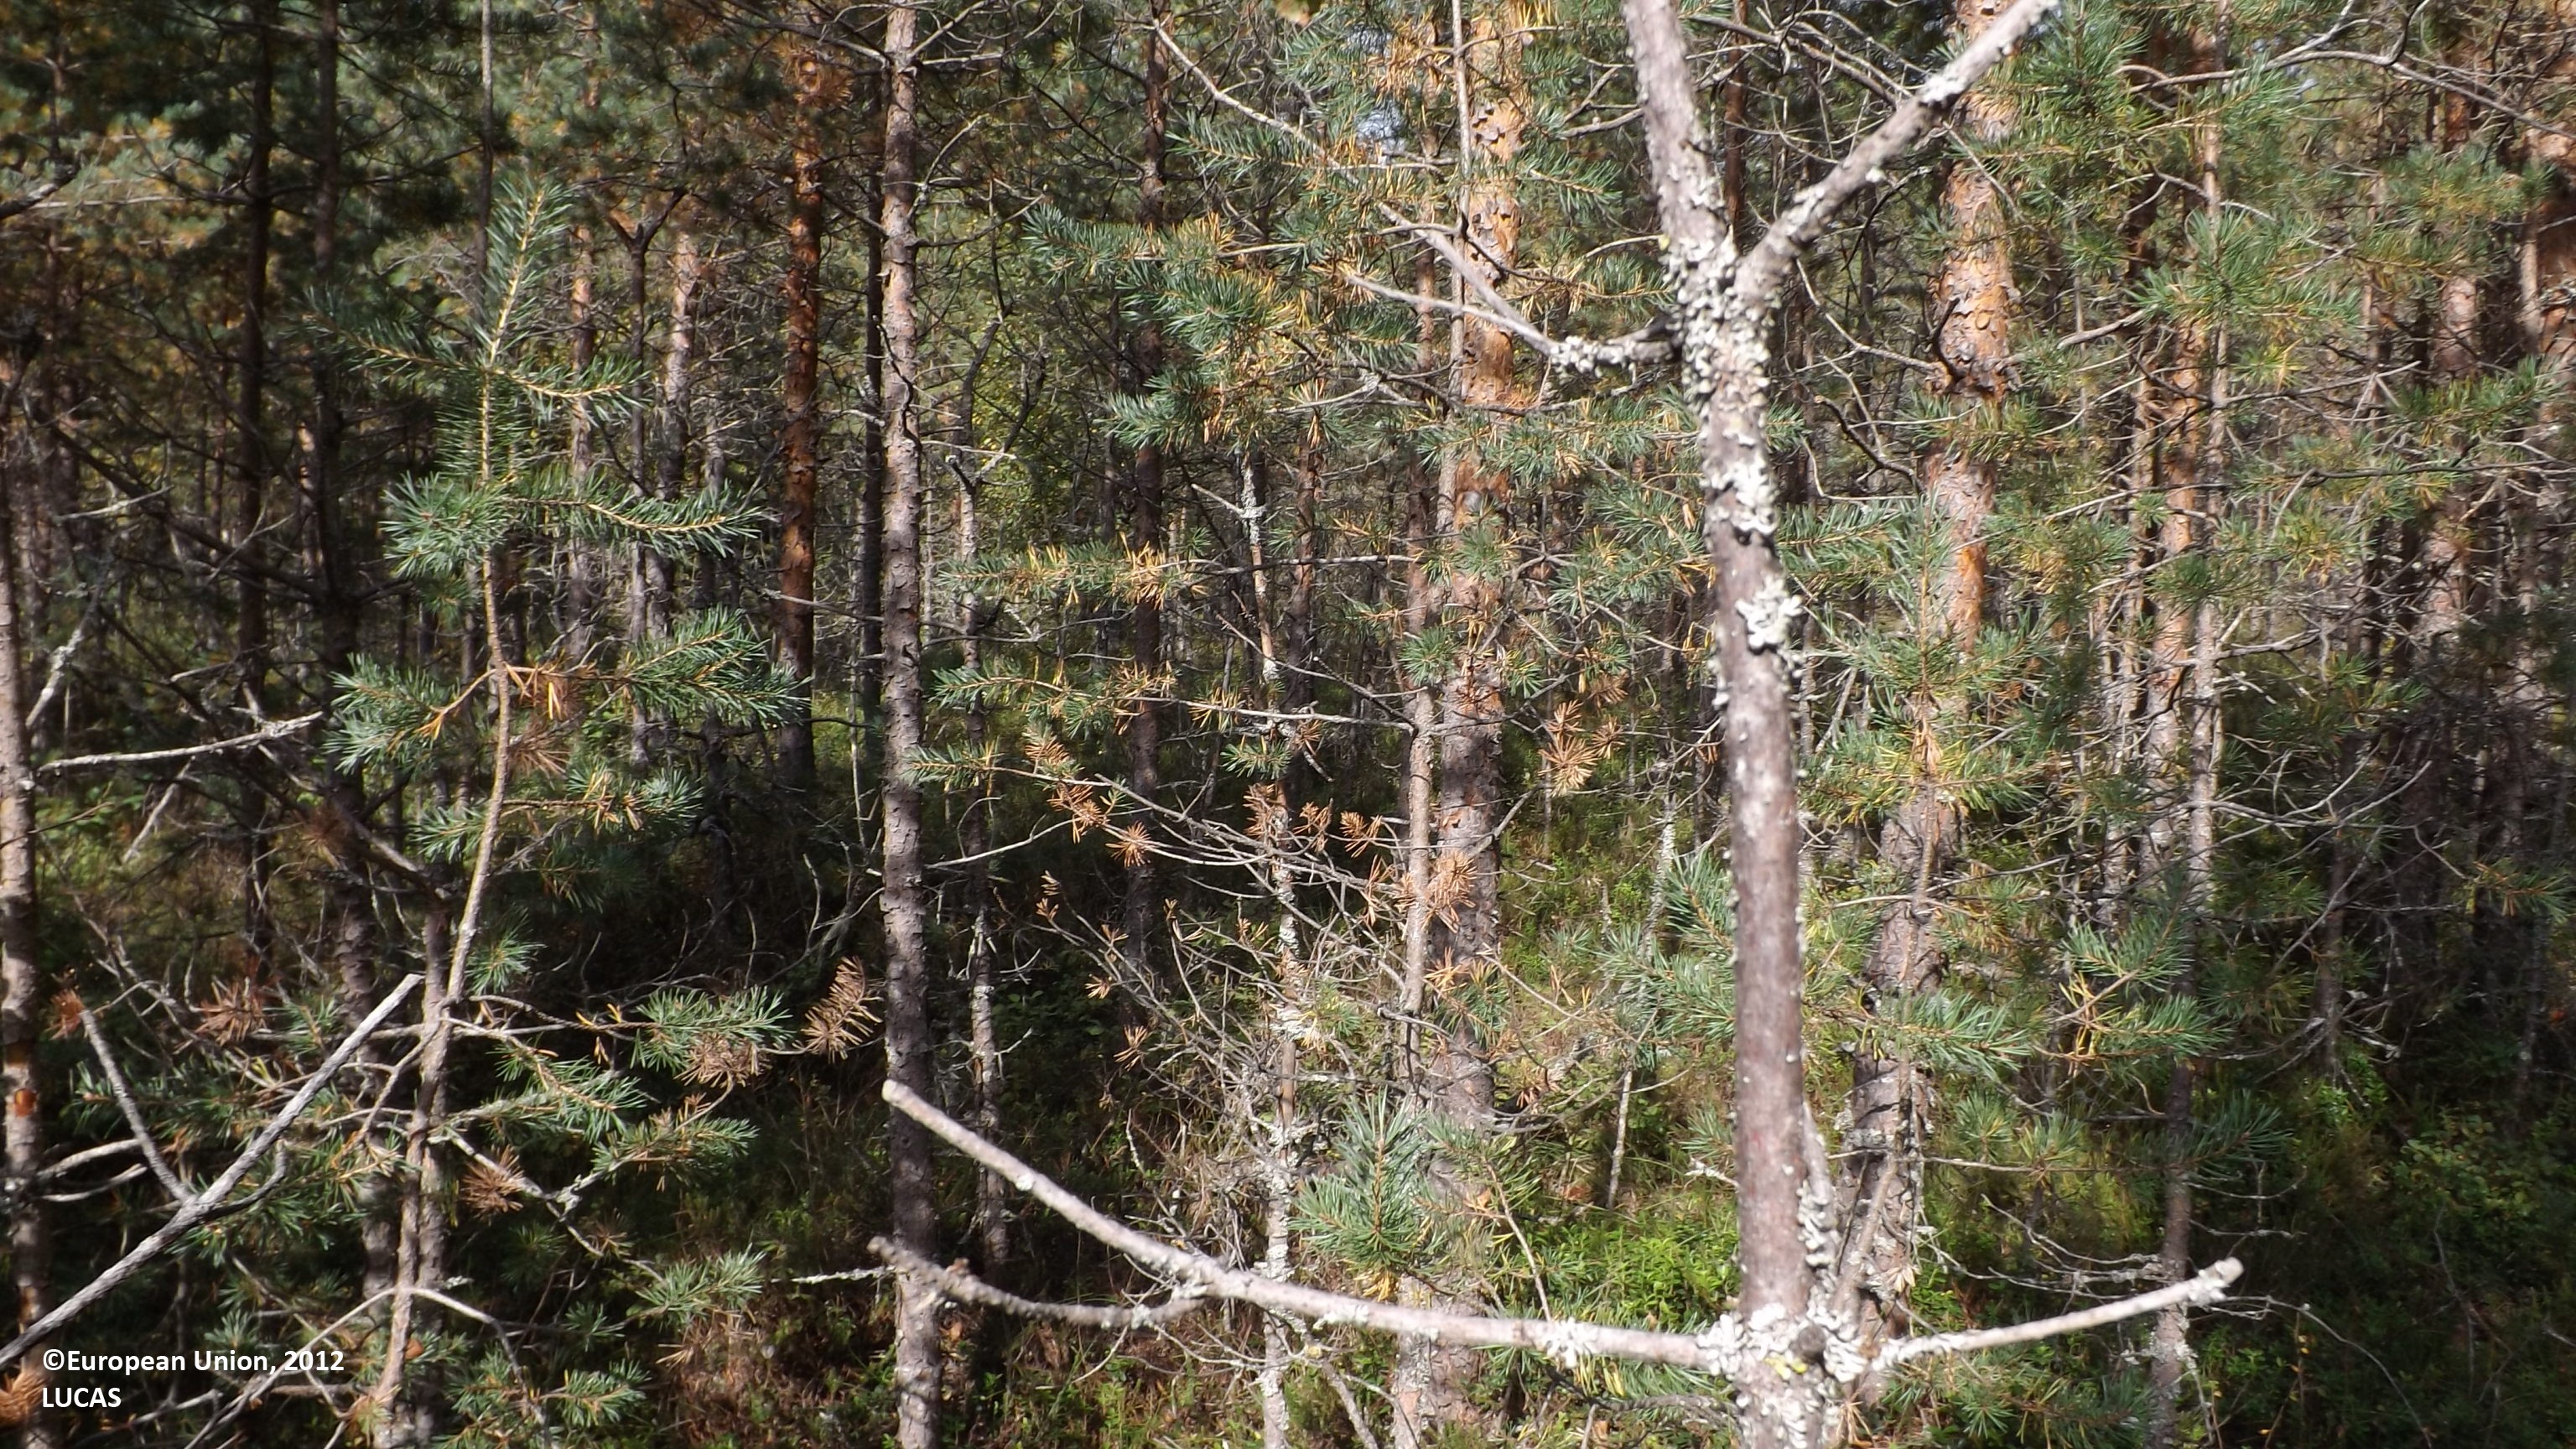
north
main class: Woodland
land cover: Pine dominated coniferous woodland
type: boreal forest
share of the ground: 50 - 75 %
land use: Forestry
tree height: > 5 m
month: August
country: FI
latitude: 63.7347
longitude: 23.6115
